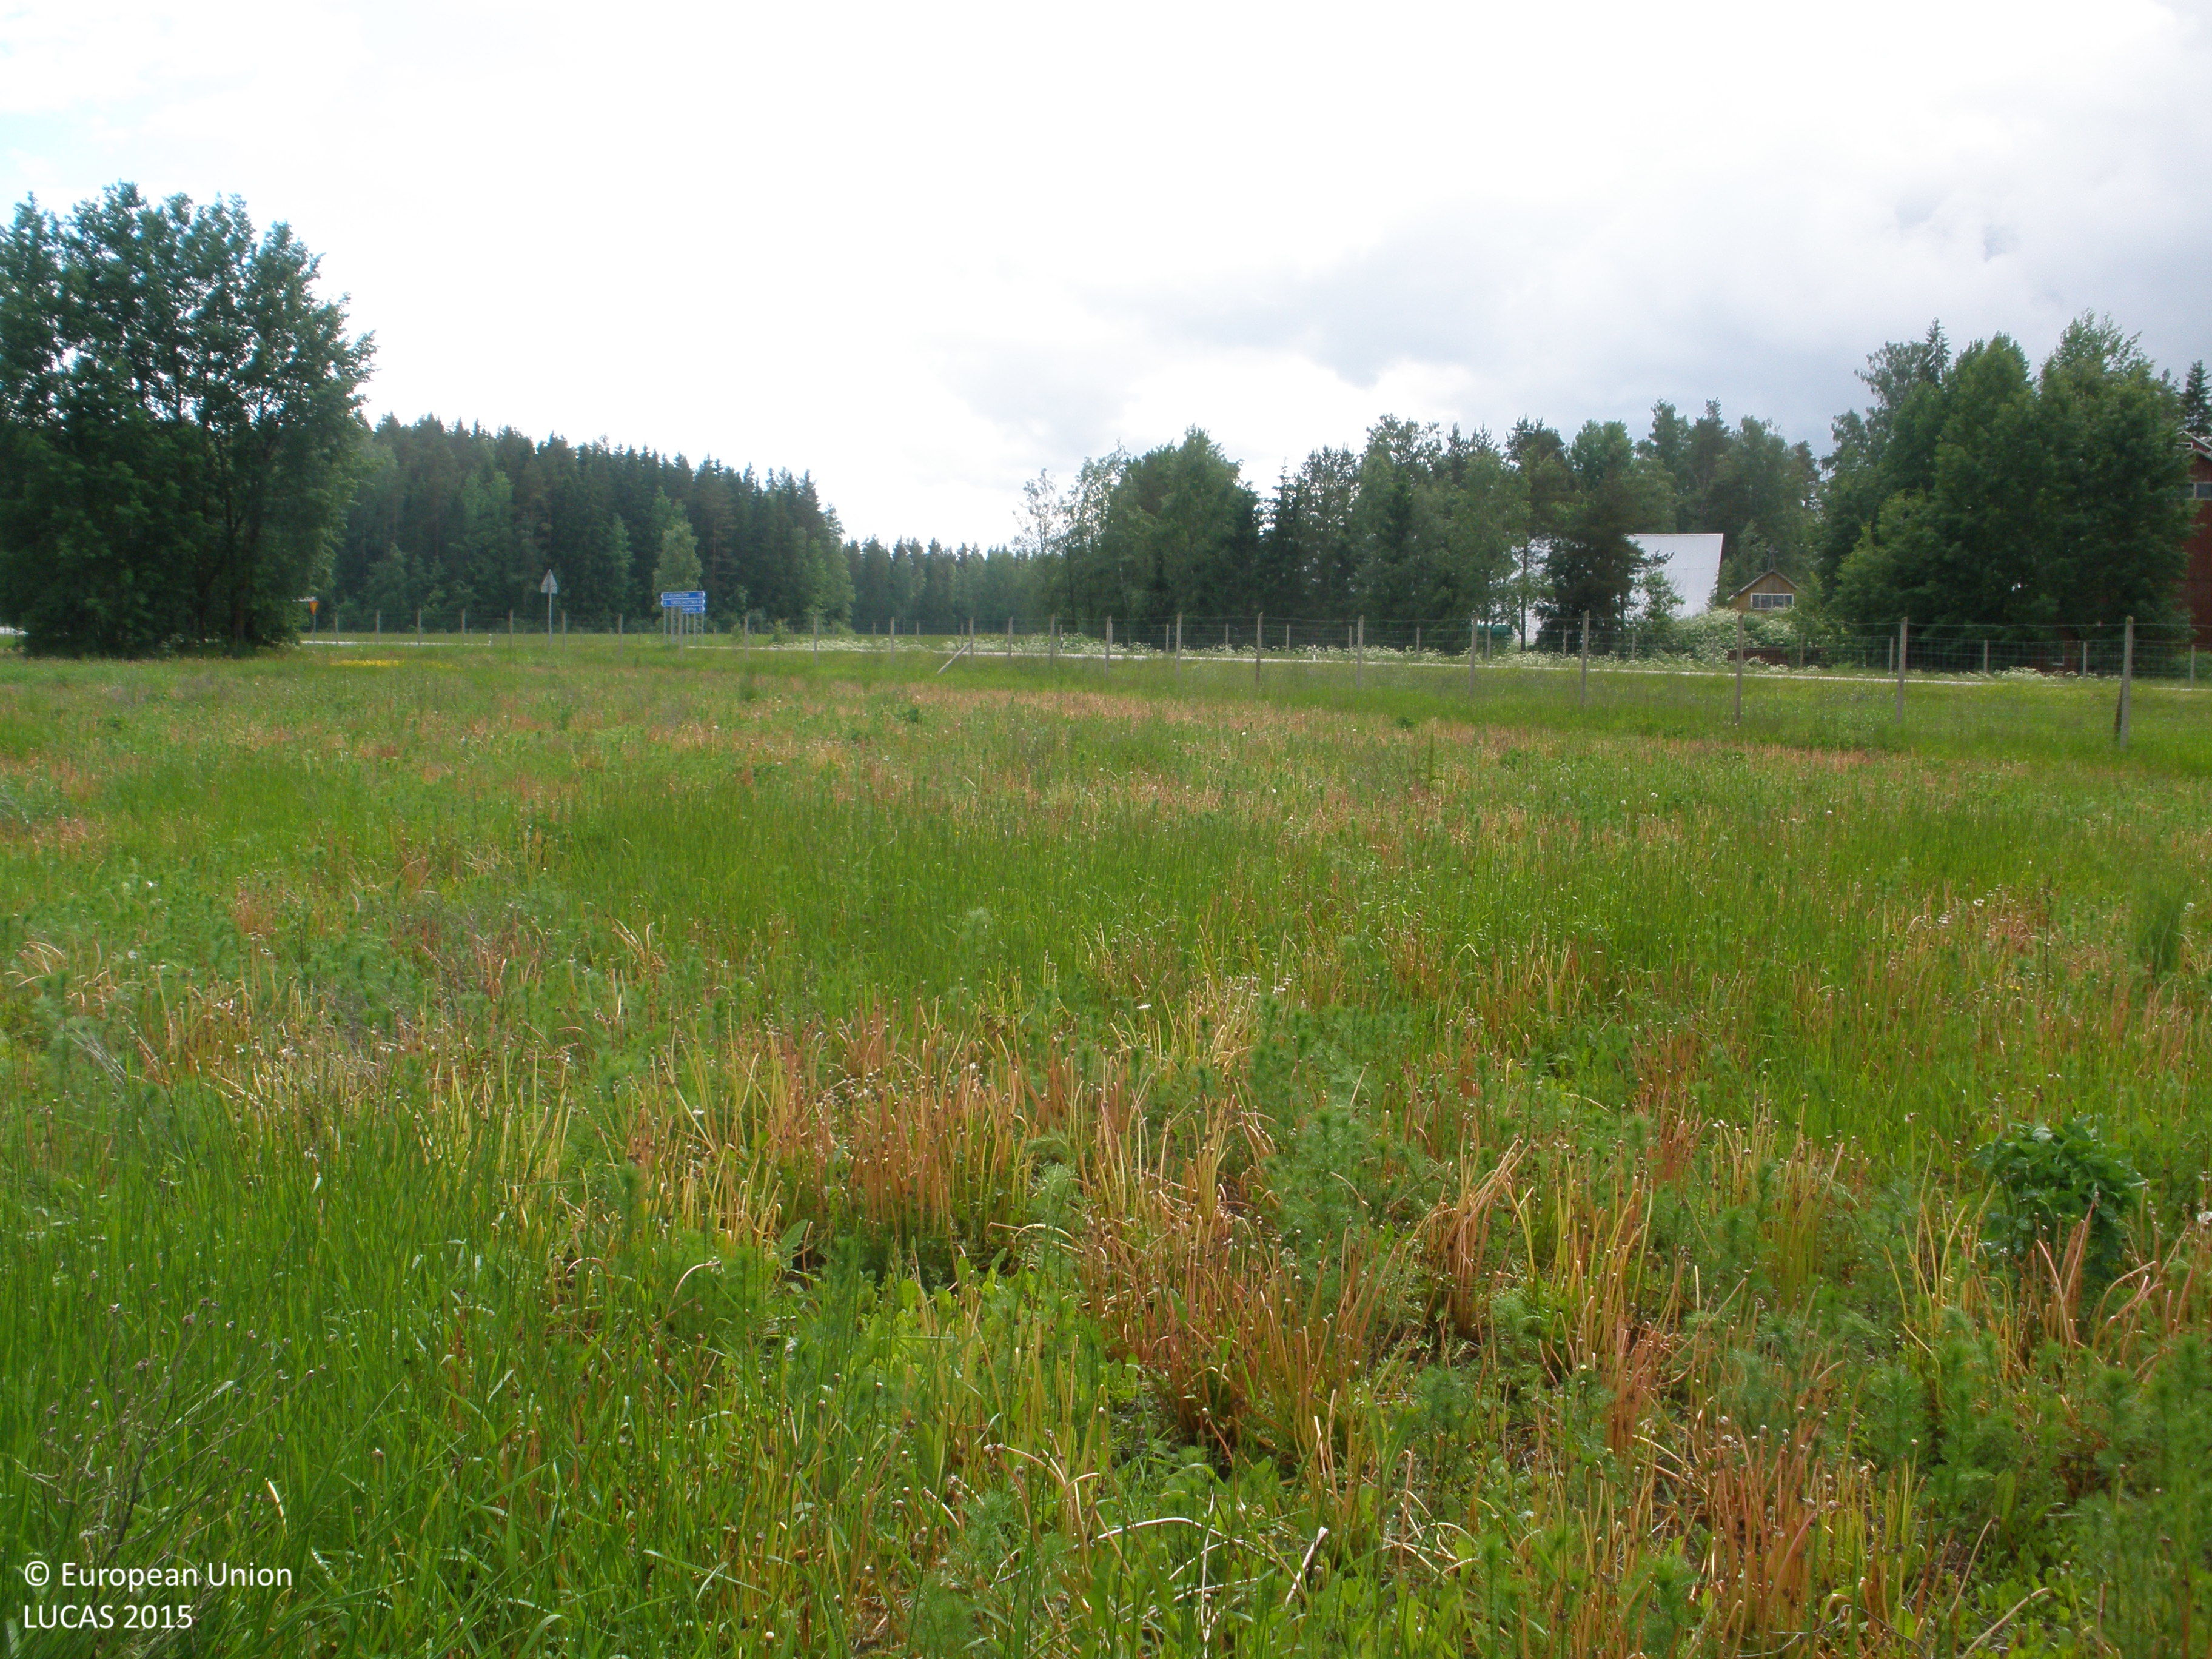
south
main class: Grassland
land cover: Spontaneously vegetated surfaces
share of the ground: > 75 %
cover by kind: herbaceous plants 95 %, shrubs 5 %
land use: Fallow land
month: June
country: FI
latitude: 60.8636
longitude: 23.5066
